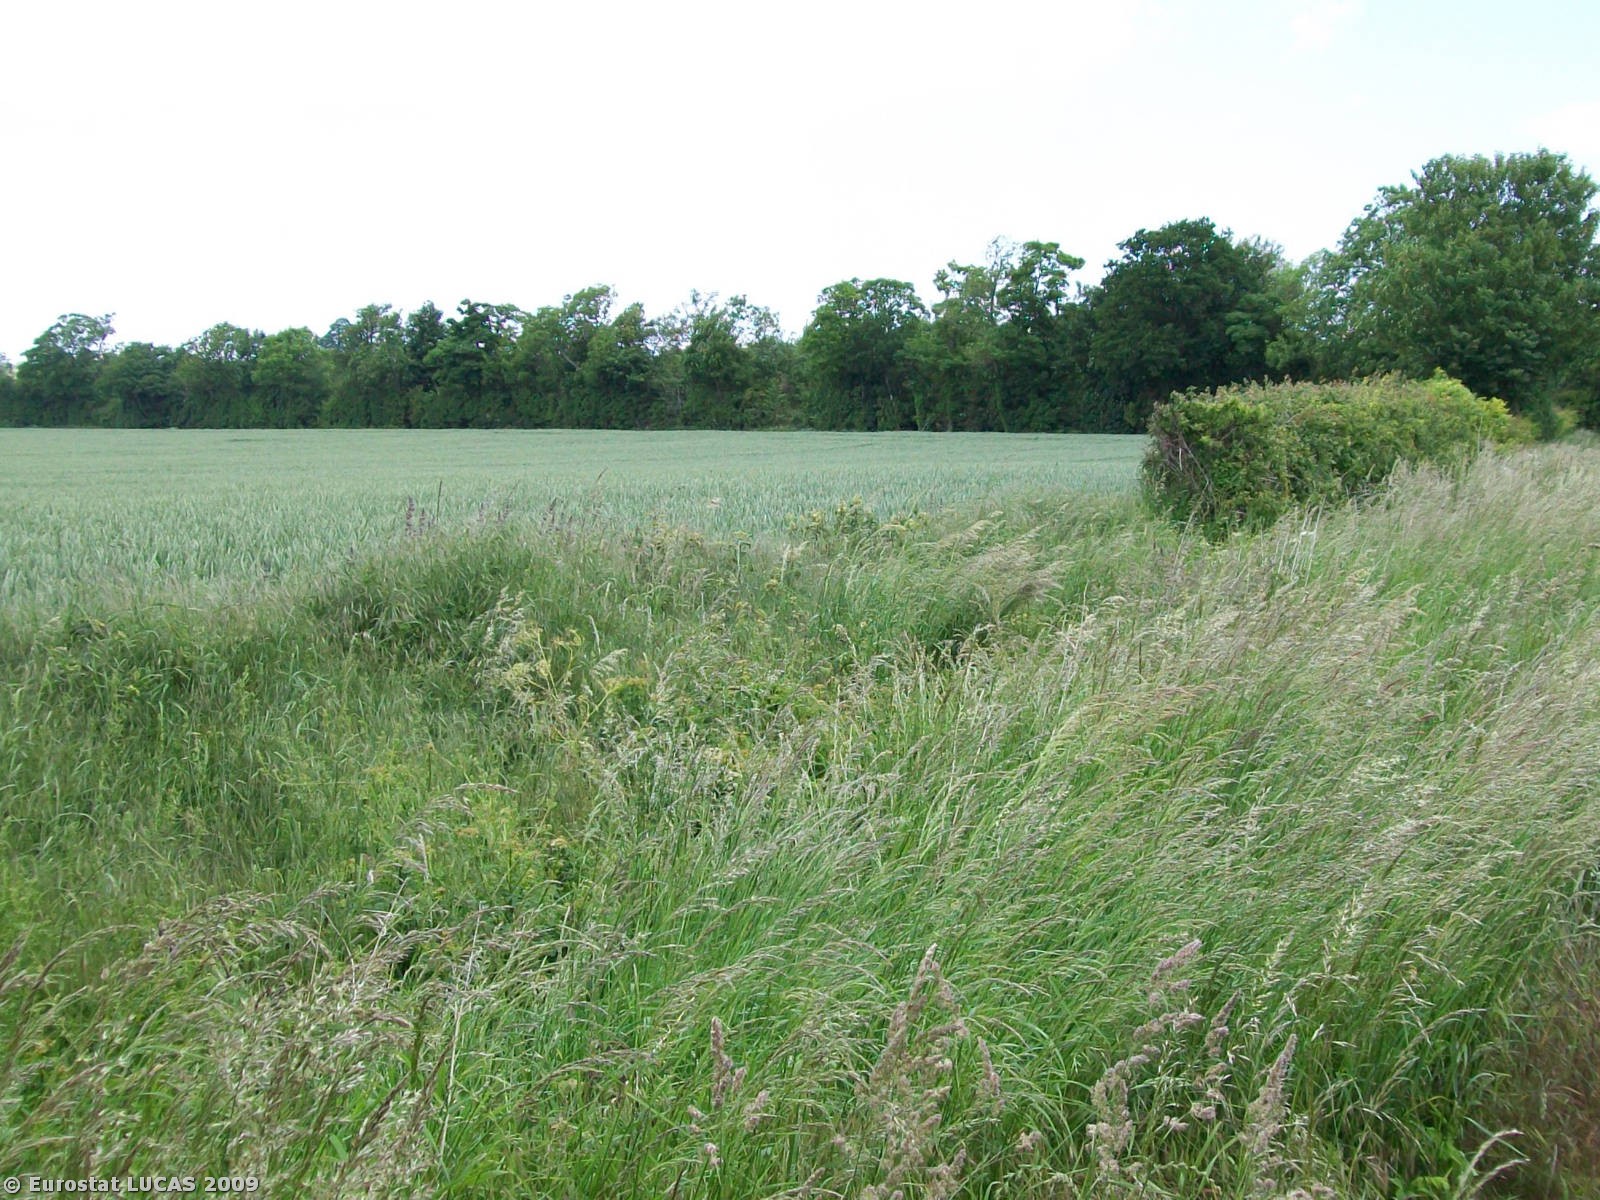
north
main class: Cropland
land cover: Barley
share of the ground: > 75 %
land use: Agriculture (excluding fallow land and kitchen gardens)
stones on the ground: < 10 %
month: June
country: GB
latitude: 50.9605
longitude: -2.7273
